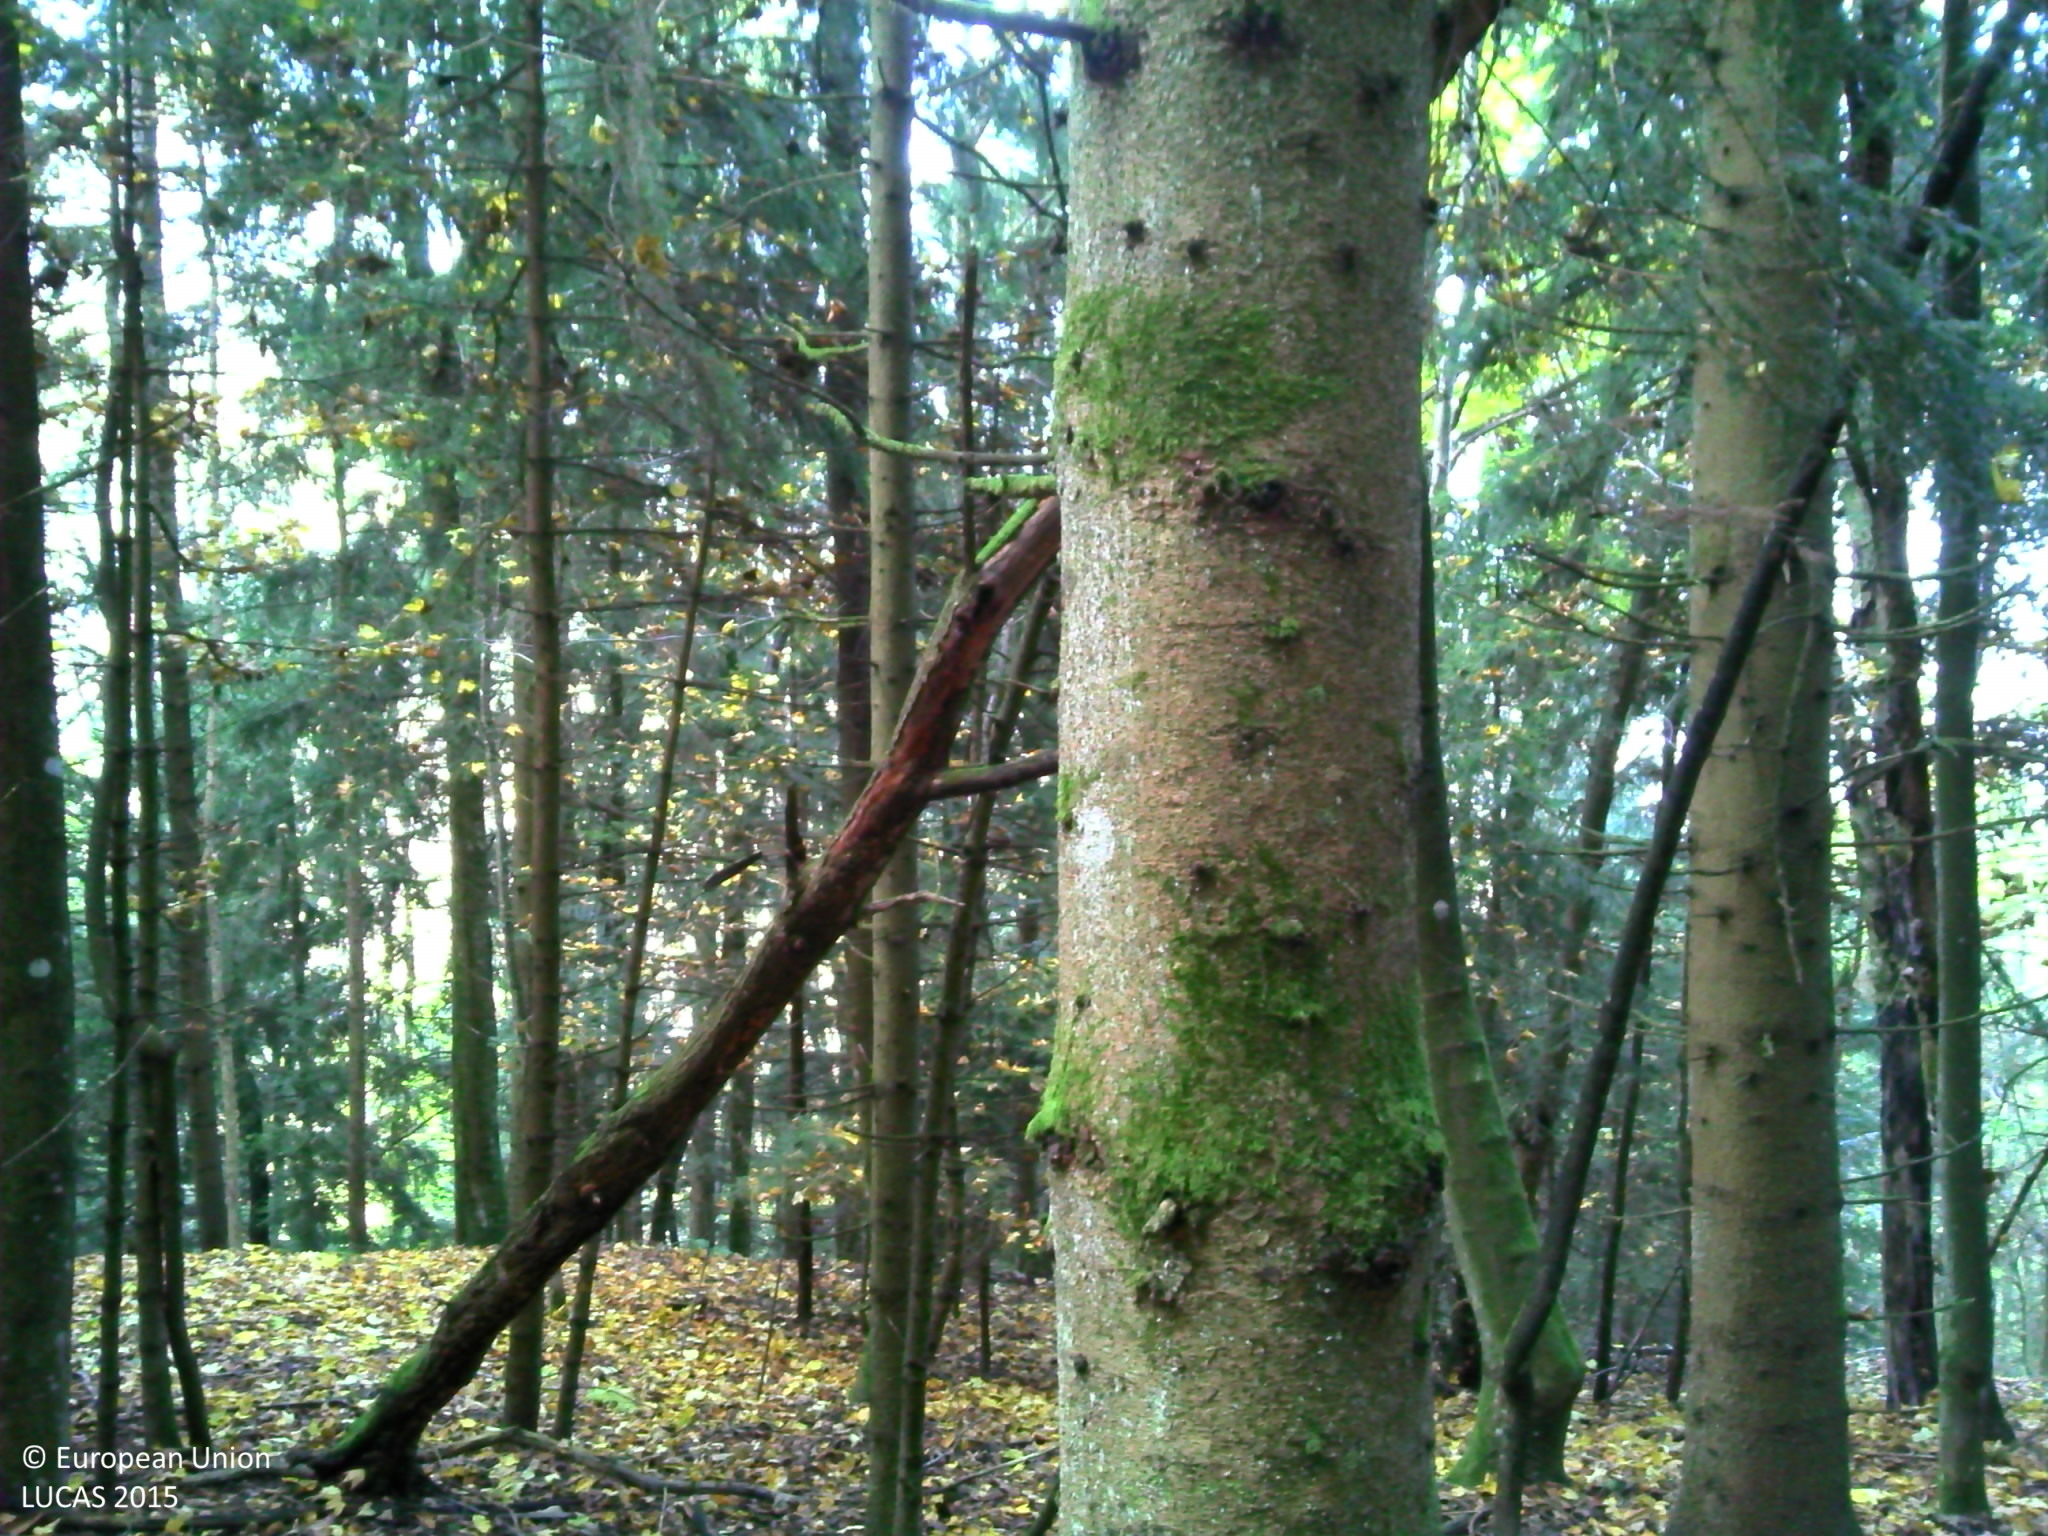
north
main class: Woodland
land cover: Spruce dominated mixed woodland
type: hemiboreal forest and nemoral coniferous forest and mixed broadleaved-coniferous forest
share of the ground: > 75 %
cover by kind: coniferous forest trees 50 %, broadleaved forest trees 35 %, unconsolidated bare surface 15 %
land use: Forestry
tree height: > 5 m
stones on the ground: < 10 %
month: October
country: FR
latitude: 45.4562
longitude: 6.2579
